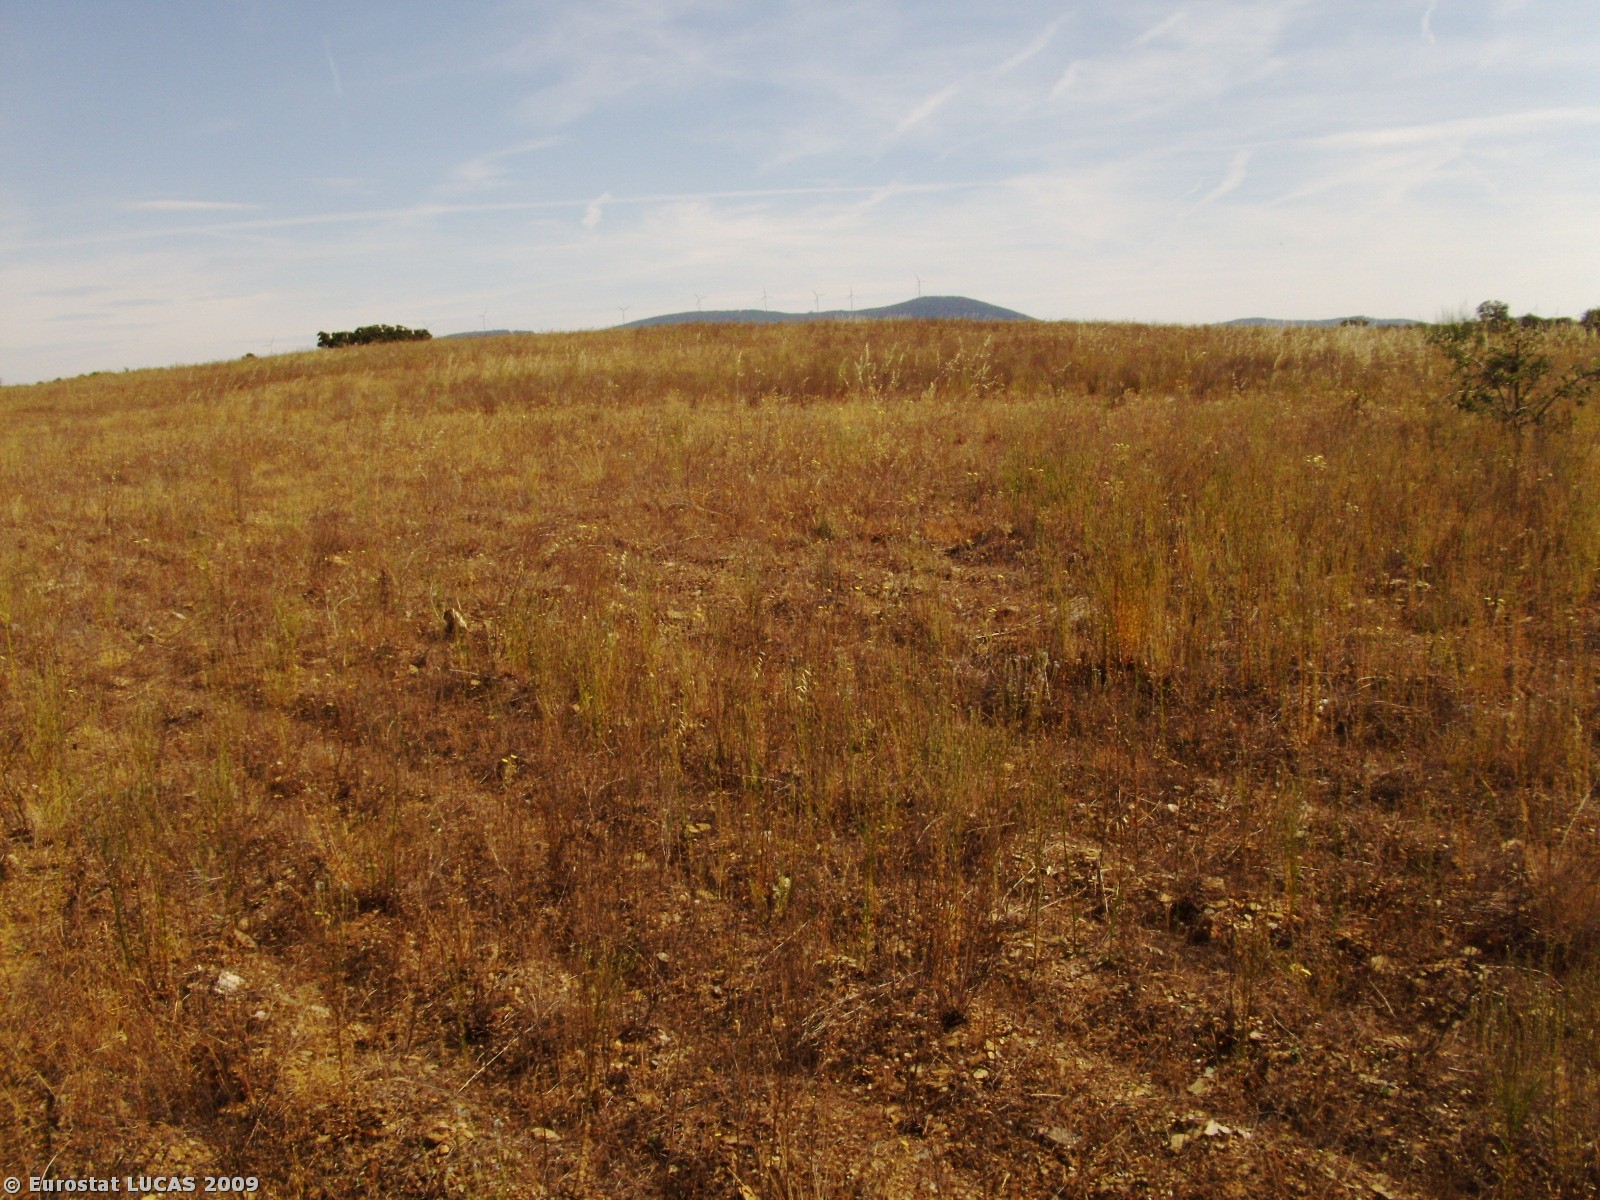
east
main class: Grassland
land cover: Spontaneously vegetated surfaces
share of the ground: > 75 %
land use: Fallow land
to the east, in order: Spontaneously vegetated surfaces; Ditches and canals; Broadleaved woodland; Shrubland with sparse tree cover
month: June
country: PT
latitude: 40.1430
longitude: -7.2717
